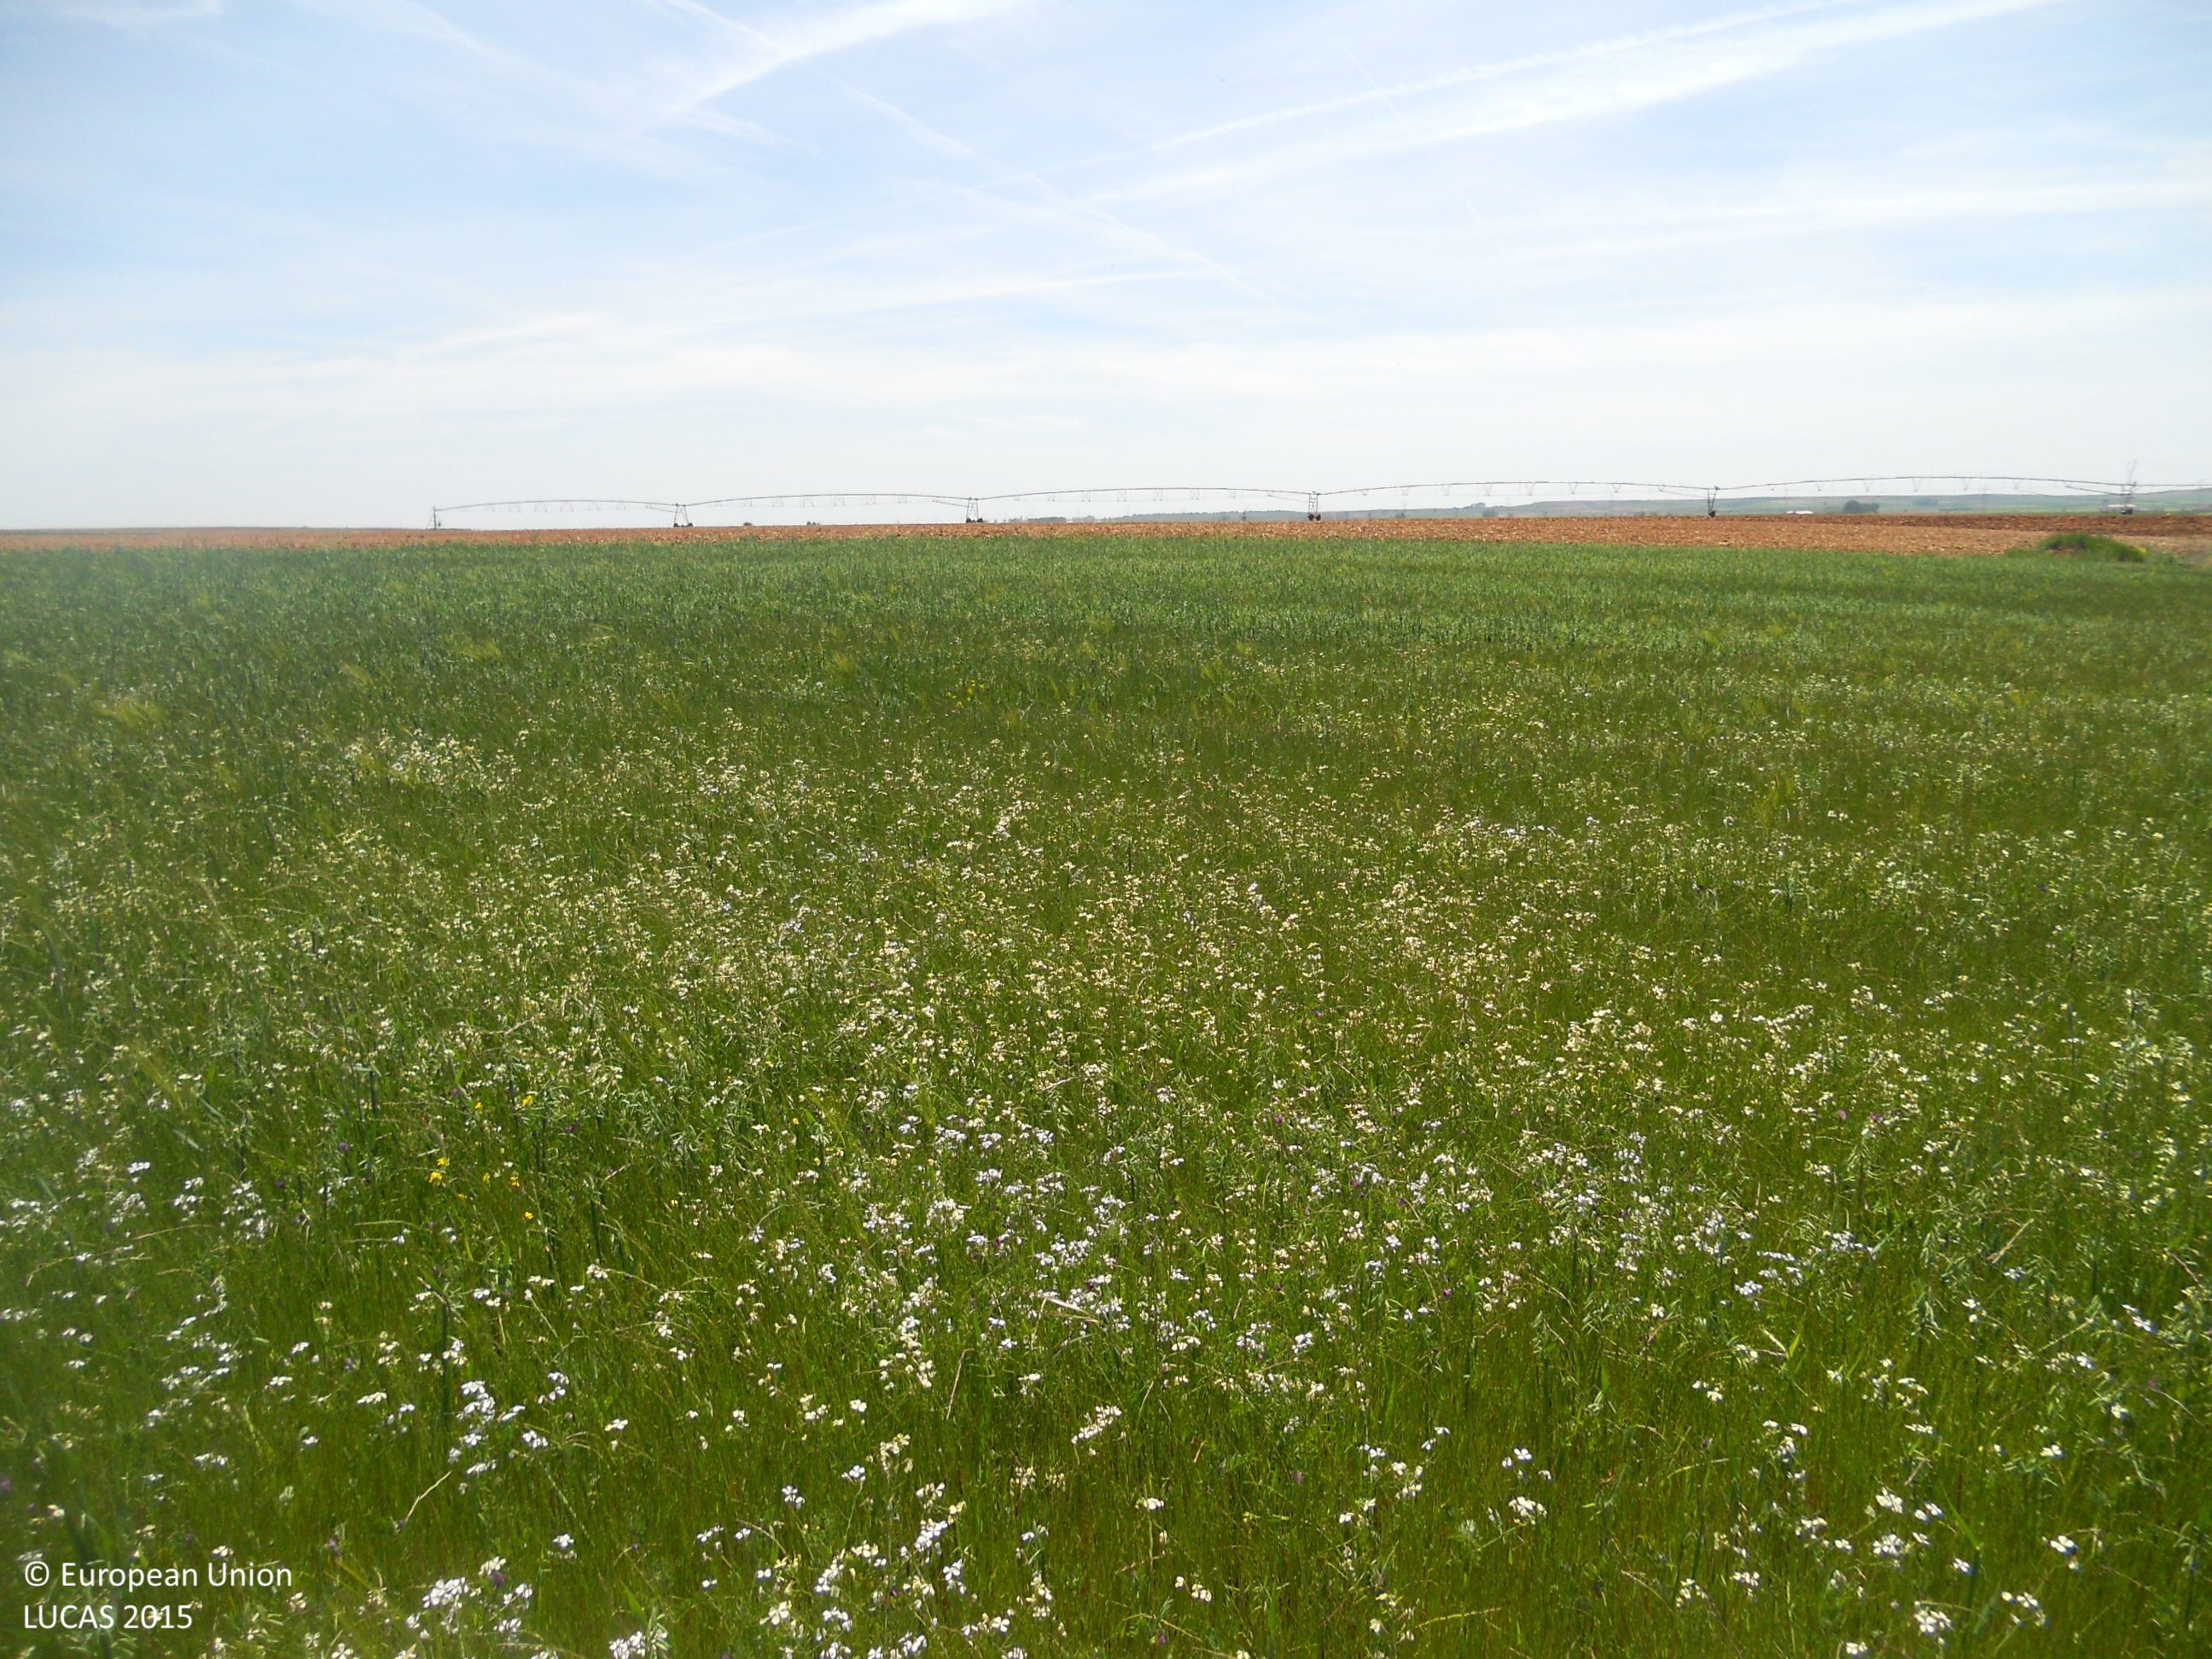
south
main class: Cropland
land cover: Mixed cereals for fodder
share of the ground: > 75 %
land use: Agriculture (excluding fallow land and kitchen gardens)
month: May
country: ES
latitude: 42.3815
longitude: -5.3076
